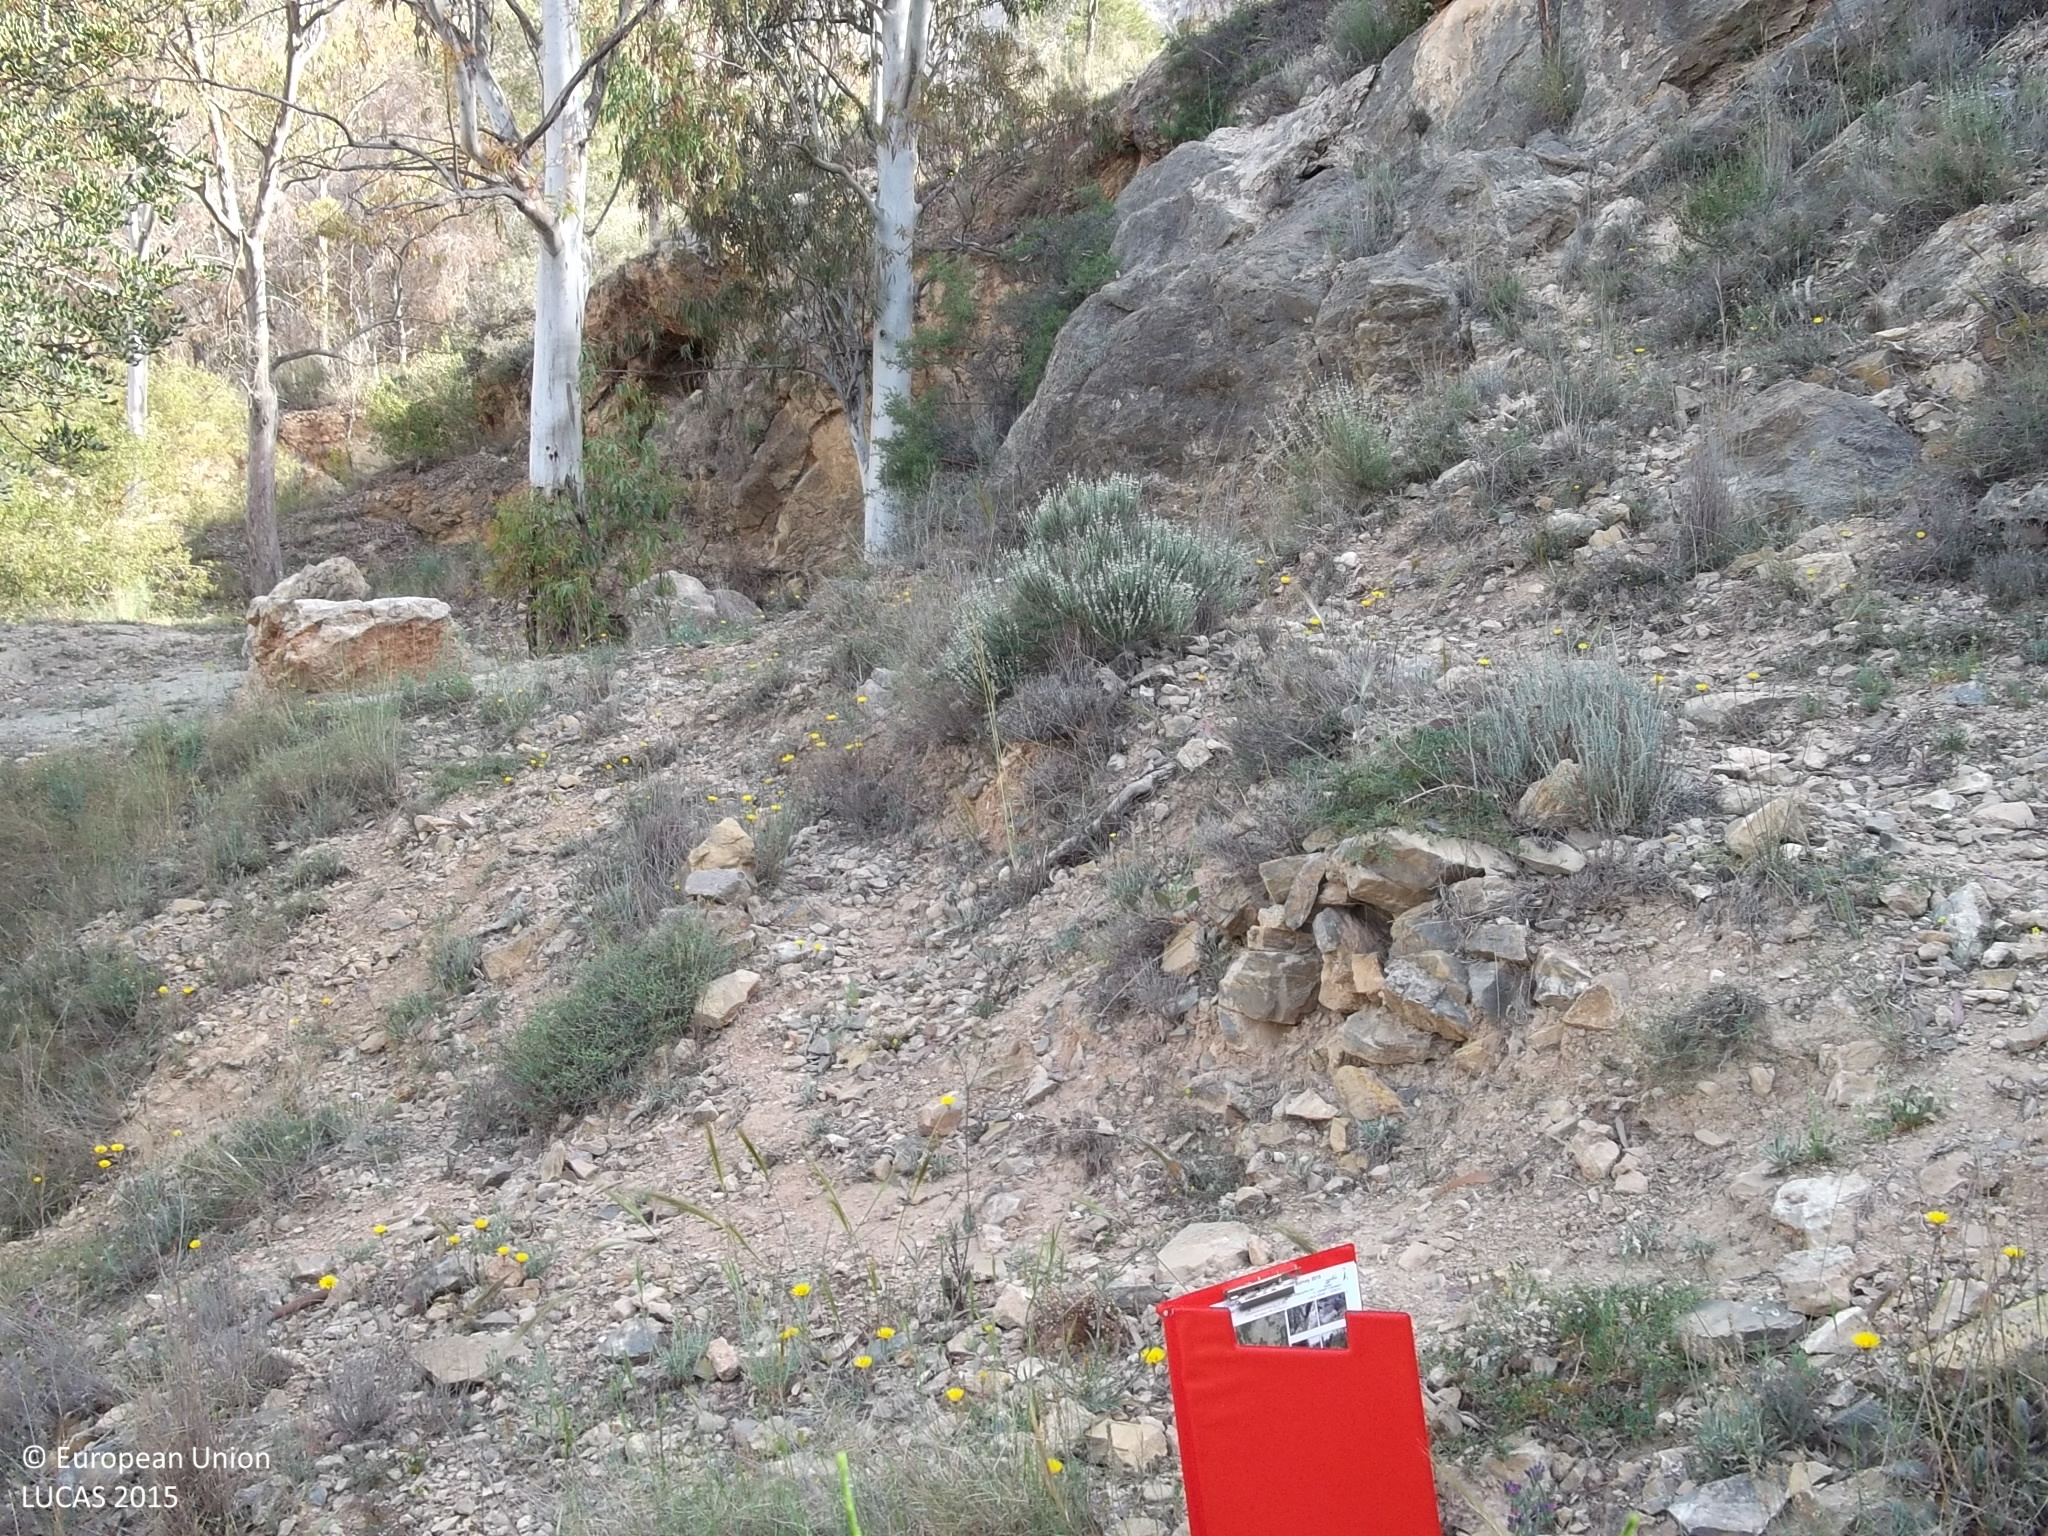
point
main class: Shrubland
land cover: Shrubland with sparse tree cover
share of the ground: 10 - 25 %
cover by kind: herbaceous plants 65 %, shrubs 30 %, broadleaved forest trees 5 %
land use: Semi-natural and natural areas not in use
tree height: > 5 m
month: April
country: ES
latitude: 38.0986
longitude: -0.9658
